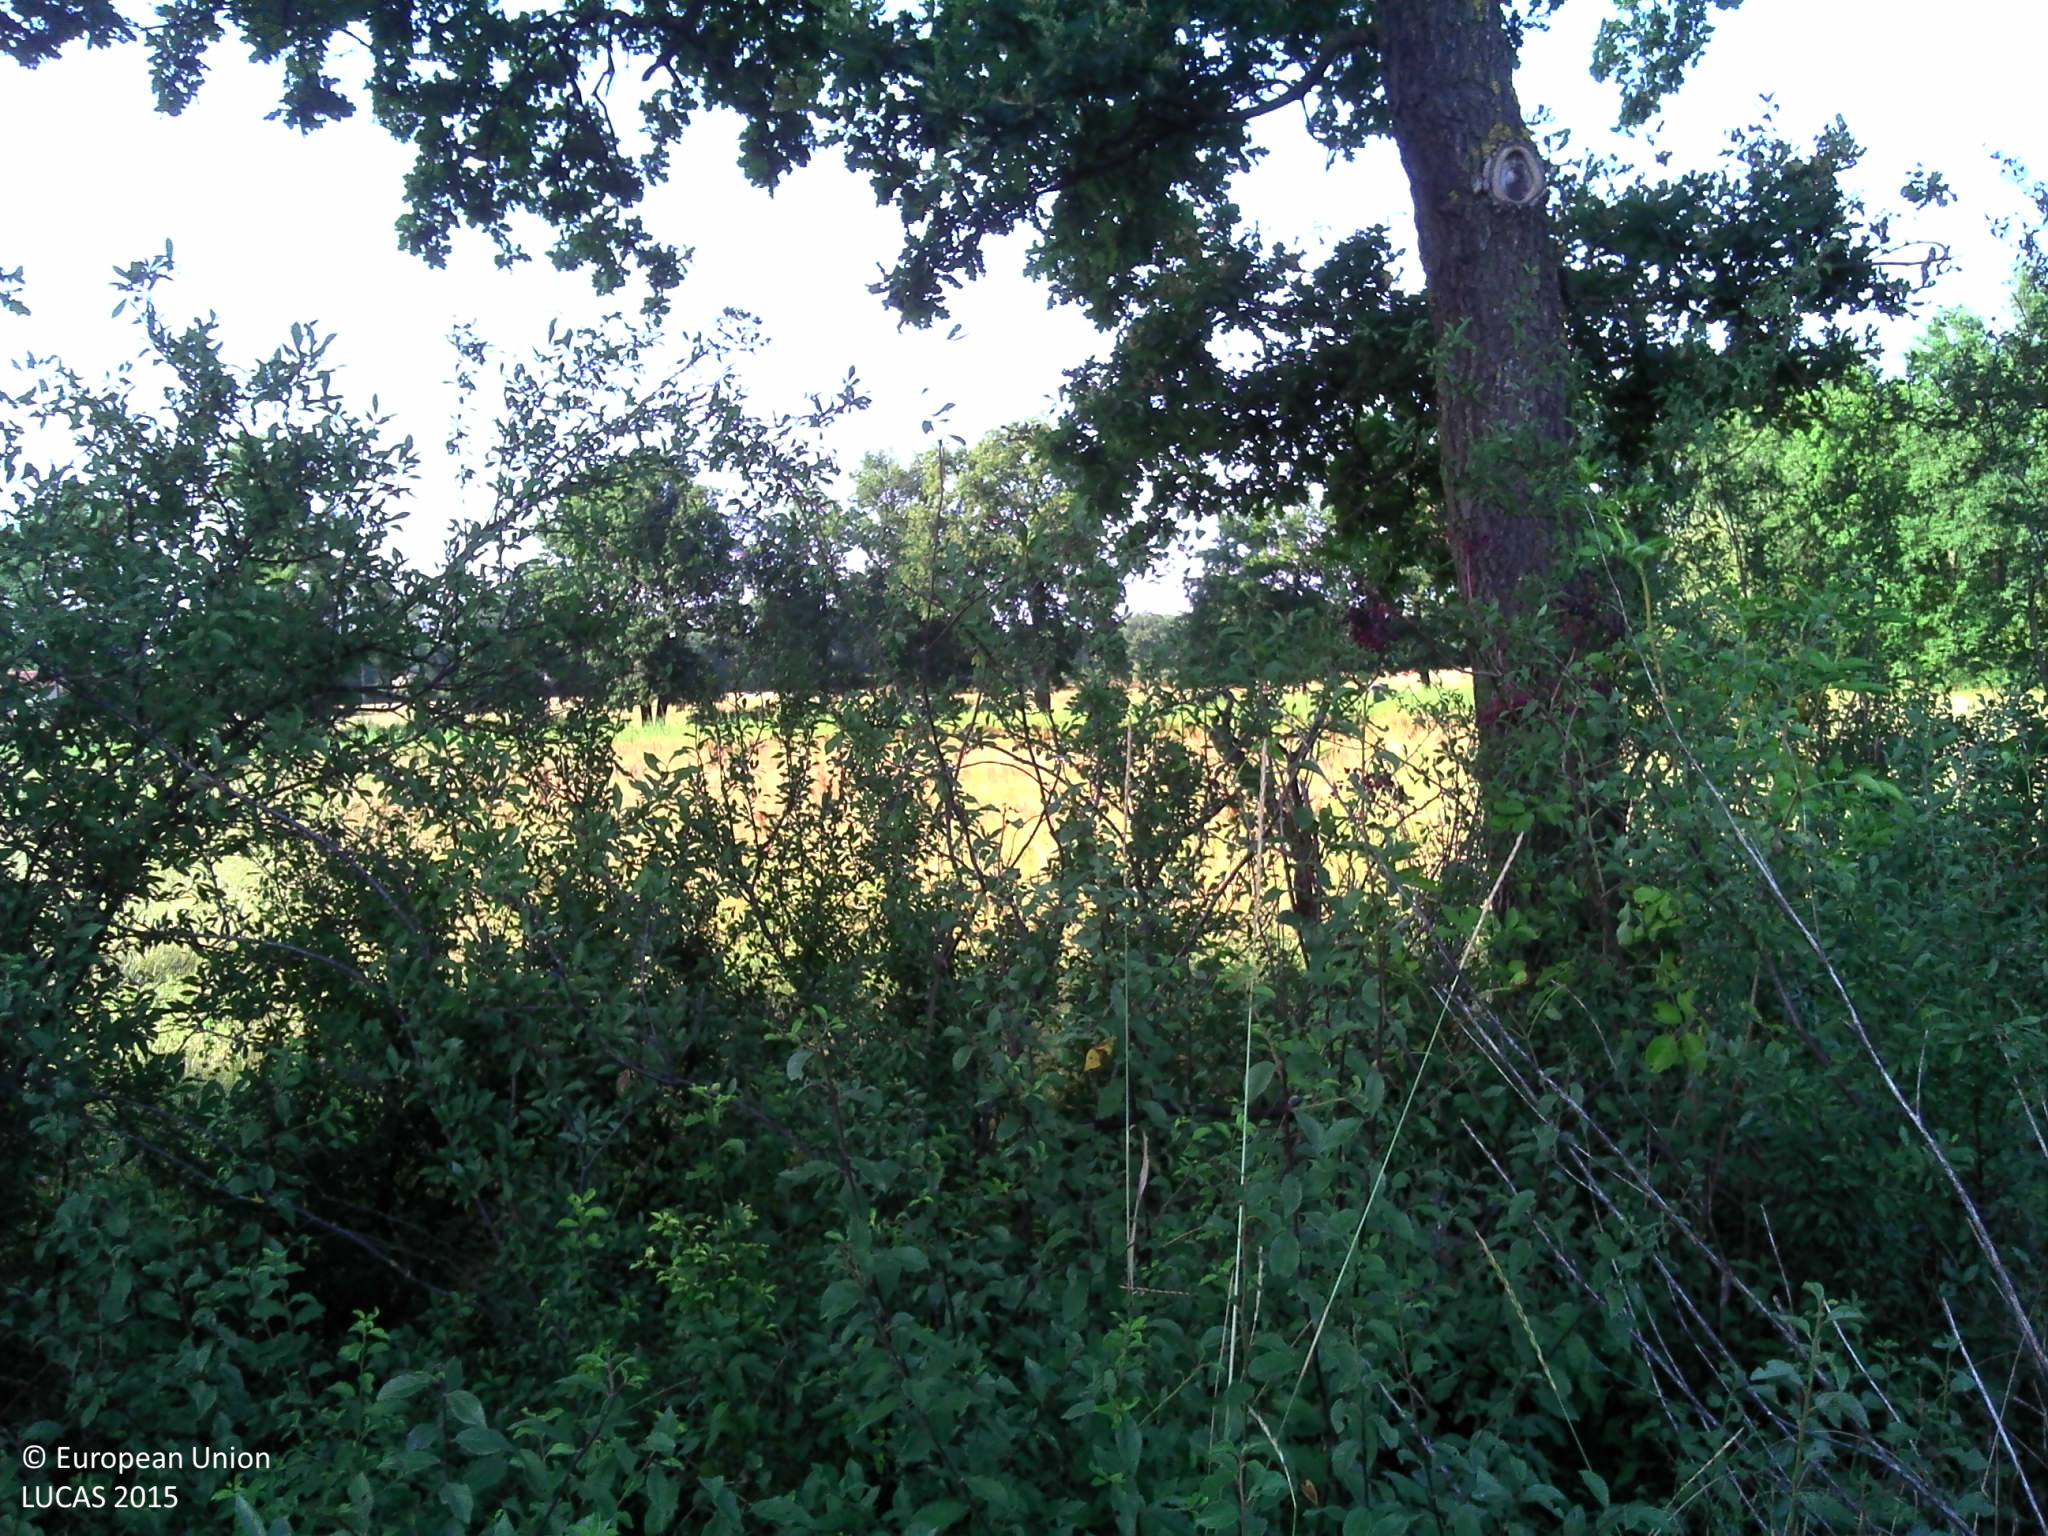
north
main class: Cropland
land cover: Maize
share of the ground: > 75 %
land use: Agriculture (excluding fallow land and kitchen gardens)
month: August
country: FR
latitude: 45.6666
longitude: 4.1369
